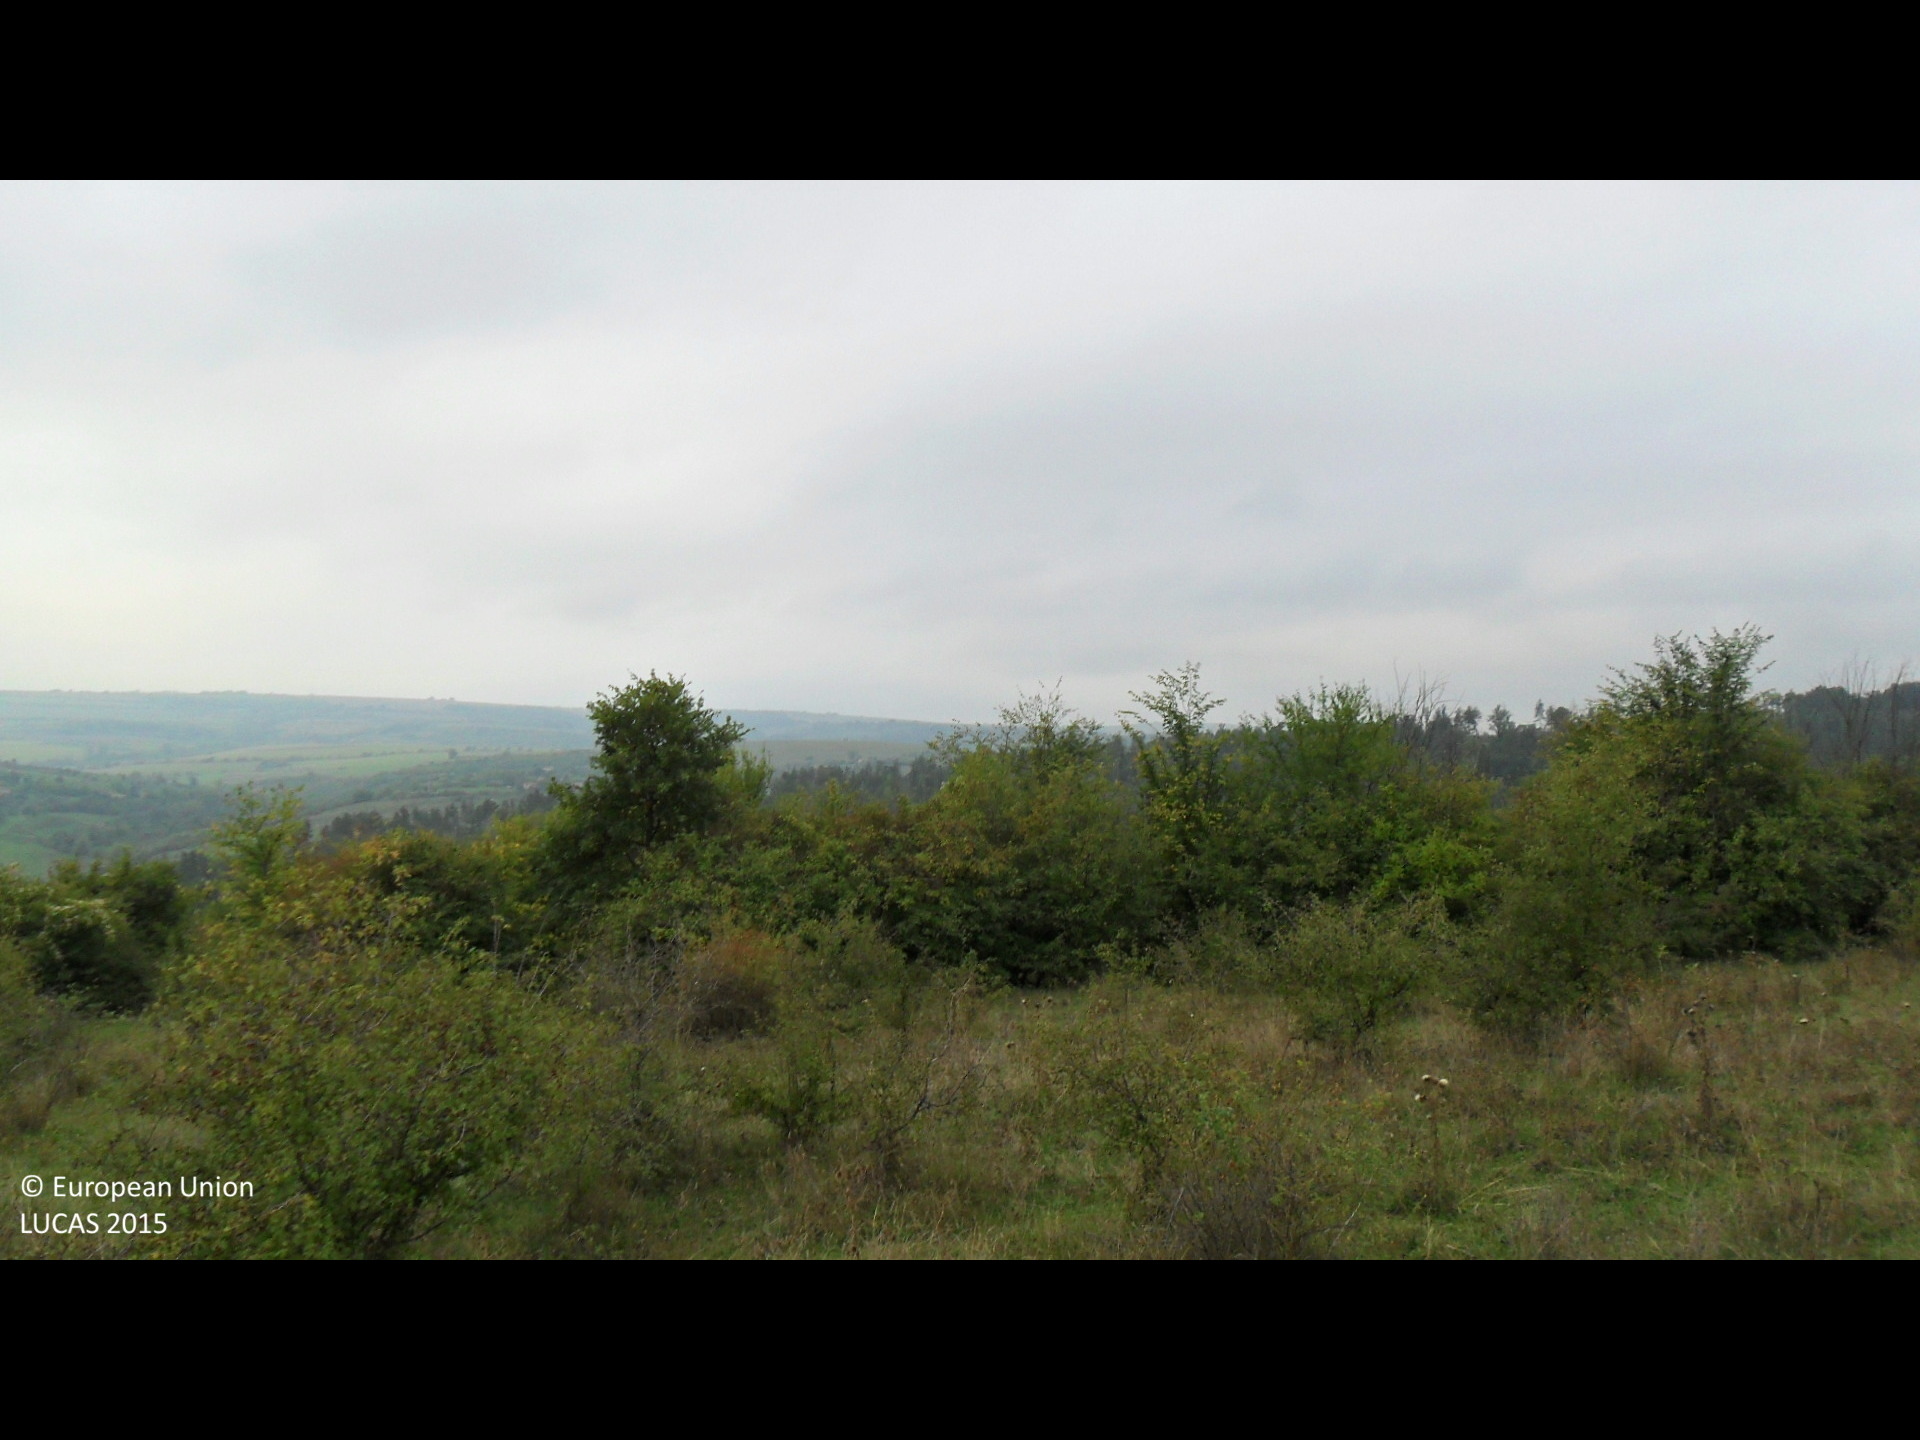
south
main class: Grassland
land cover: Grassland with sparse tree/shrub cover
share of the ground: > 75 %
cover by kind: herbaceous plants 90 %, broadleaved forest trees 5 %, shrubs 5 %
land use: Agriculture (excluding fallow land and kitchen gardens)
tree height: < 5 m
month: September
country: BG
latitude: 43.1273
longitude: 26.2837
